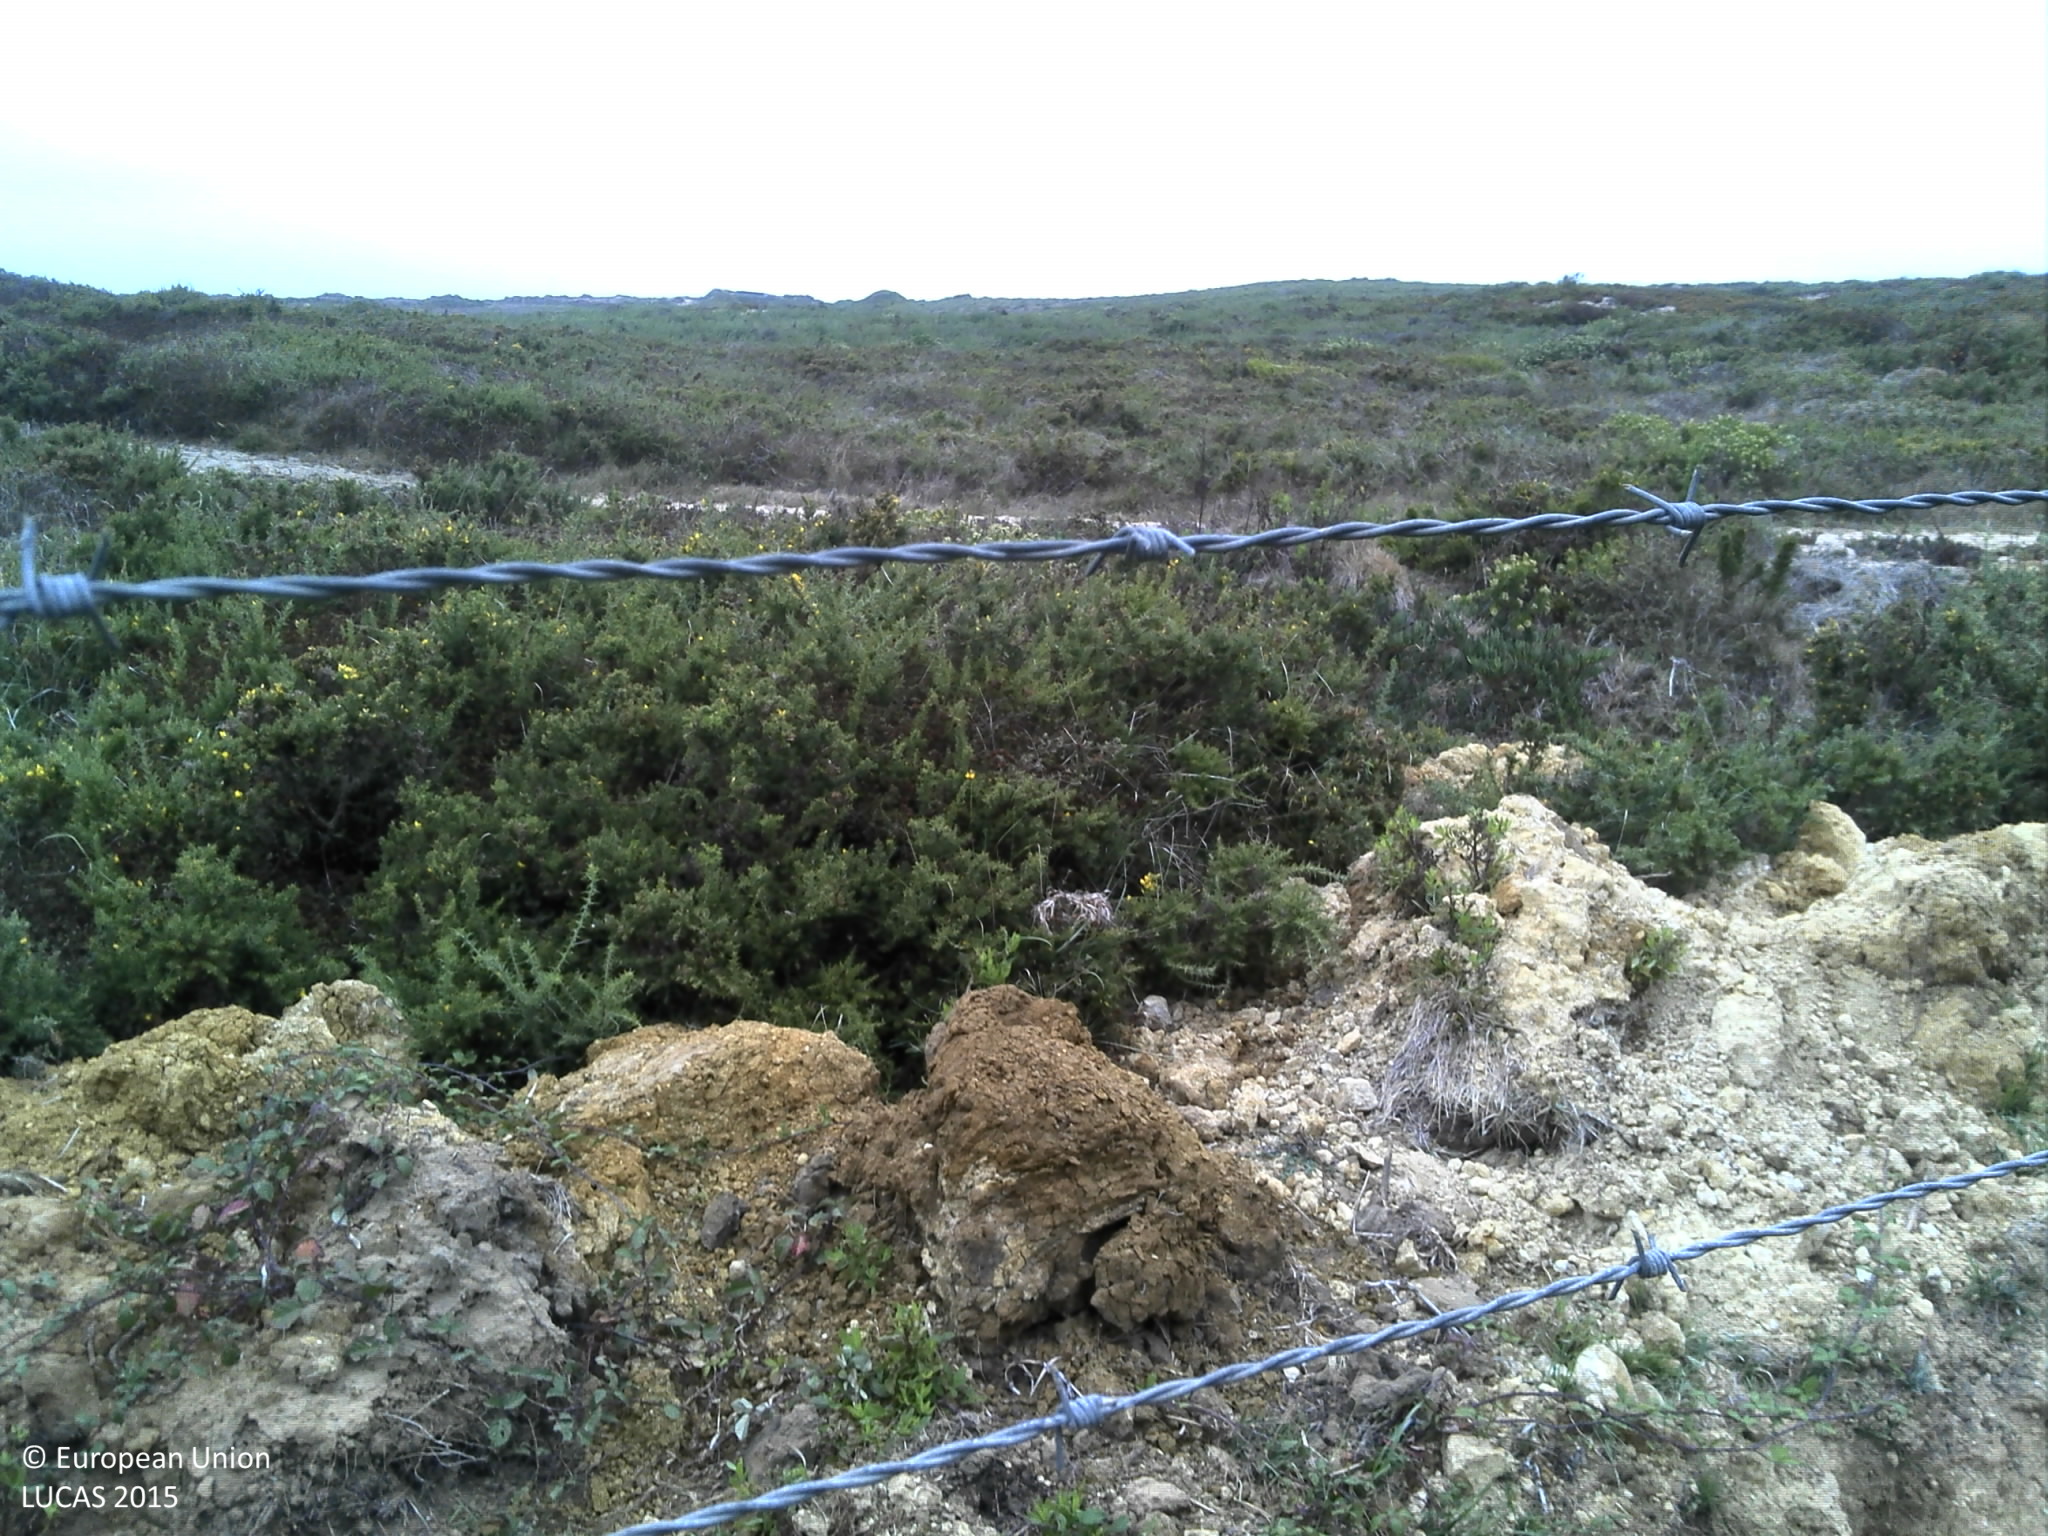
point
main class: Shrubland
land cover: Shrubland without tree cover
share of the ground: > 75 %
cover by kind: shrubs 90 %, unconsolidated bare surface 10 %
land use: Semi-natural and natural areas not in use
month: August
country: PT
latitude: 38.8764
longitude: -9.4405
